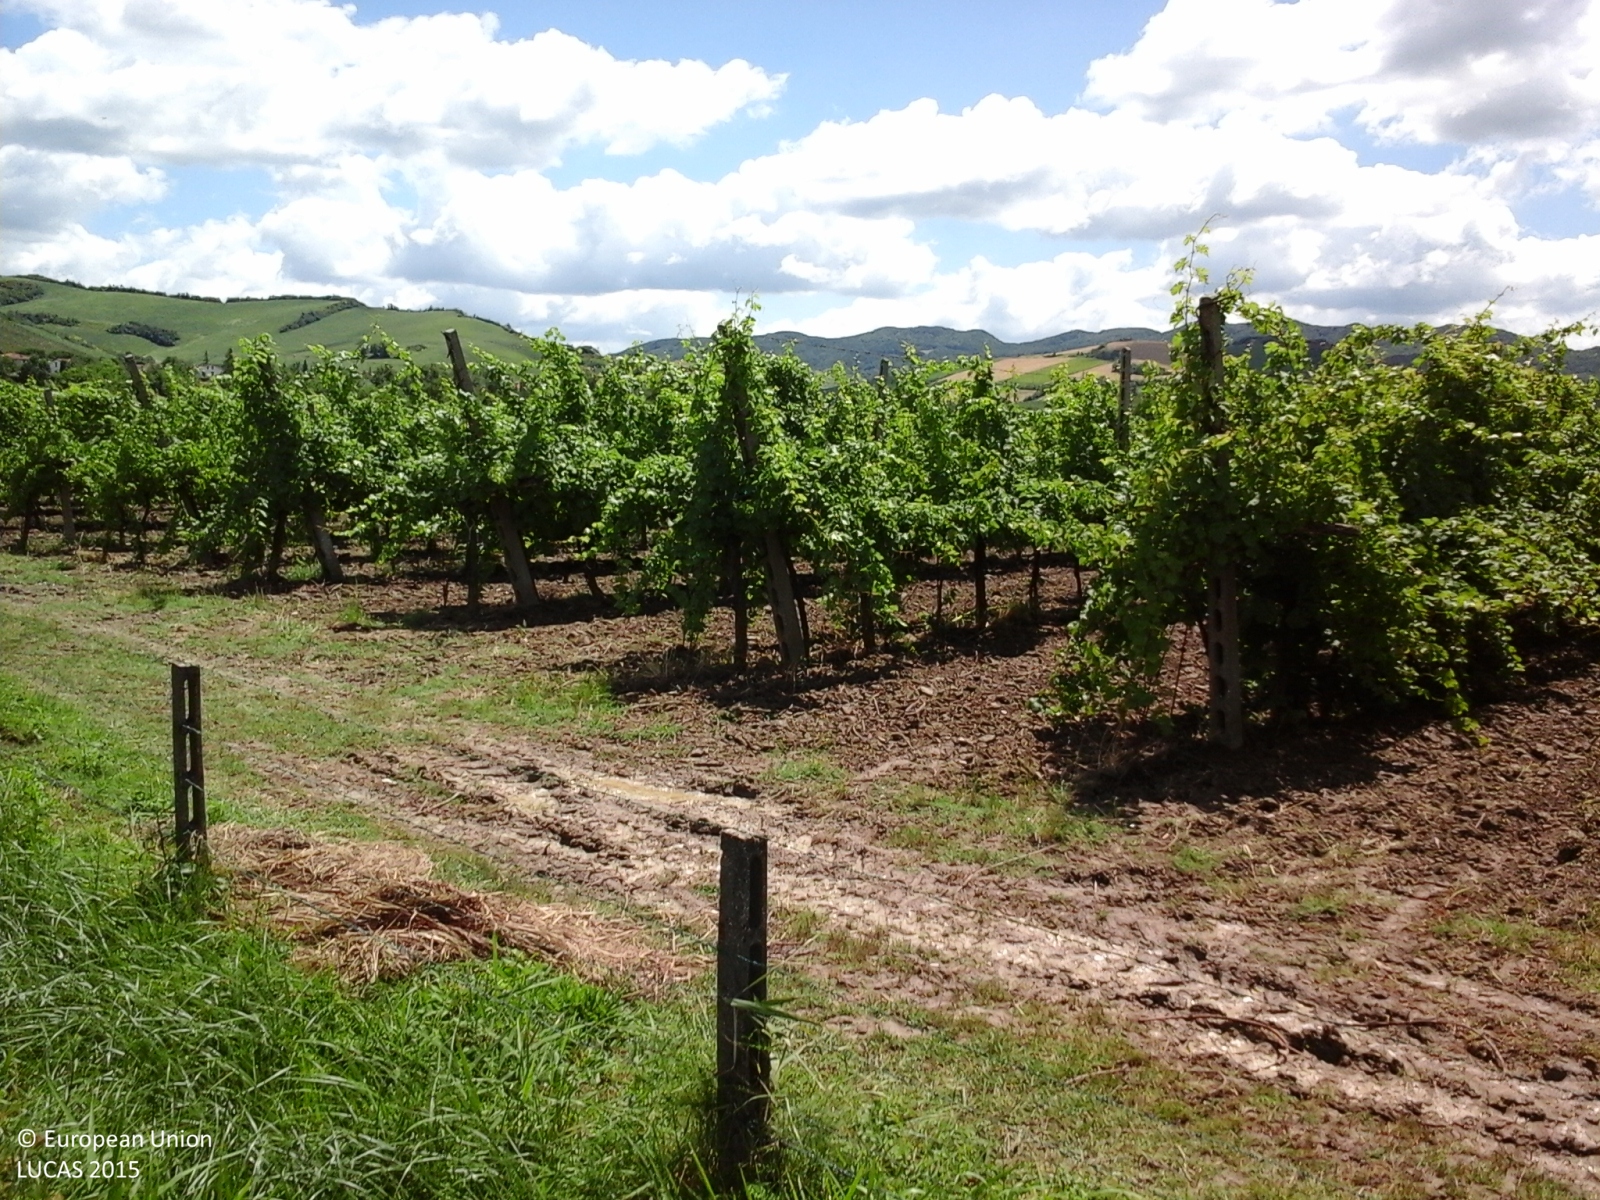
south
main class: Artificial land
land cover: Non built-up linear features
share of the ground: > 75 %
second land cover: Grassland without tree/shrub cover
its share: > 75 %
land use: Road transport
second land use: Agriculture (excluding fallow land and kitchen gardens)
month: June
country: IT
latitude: 44.3015
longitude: 11.6383
